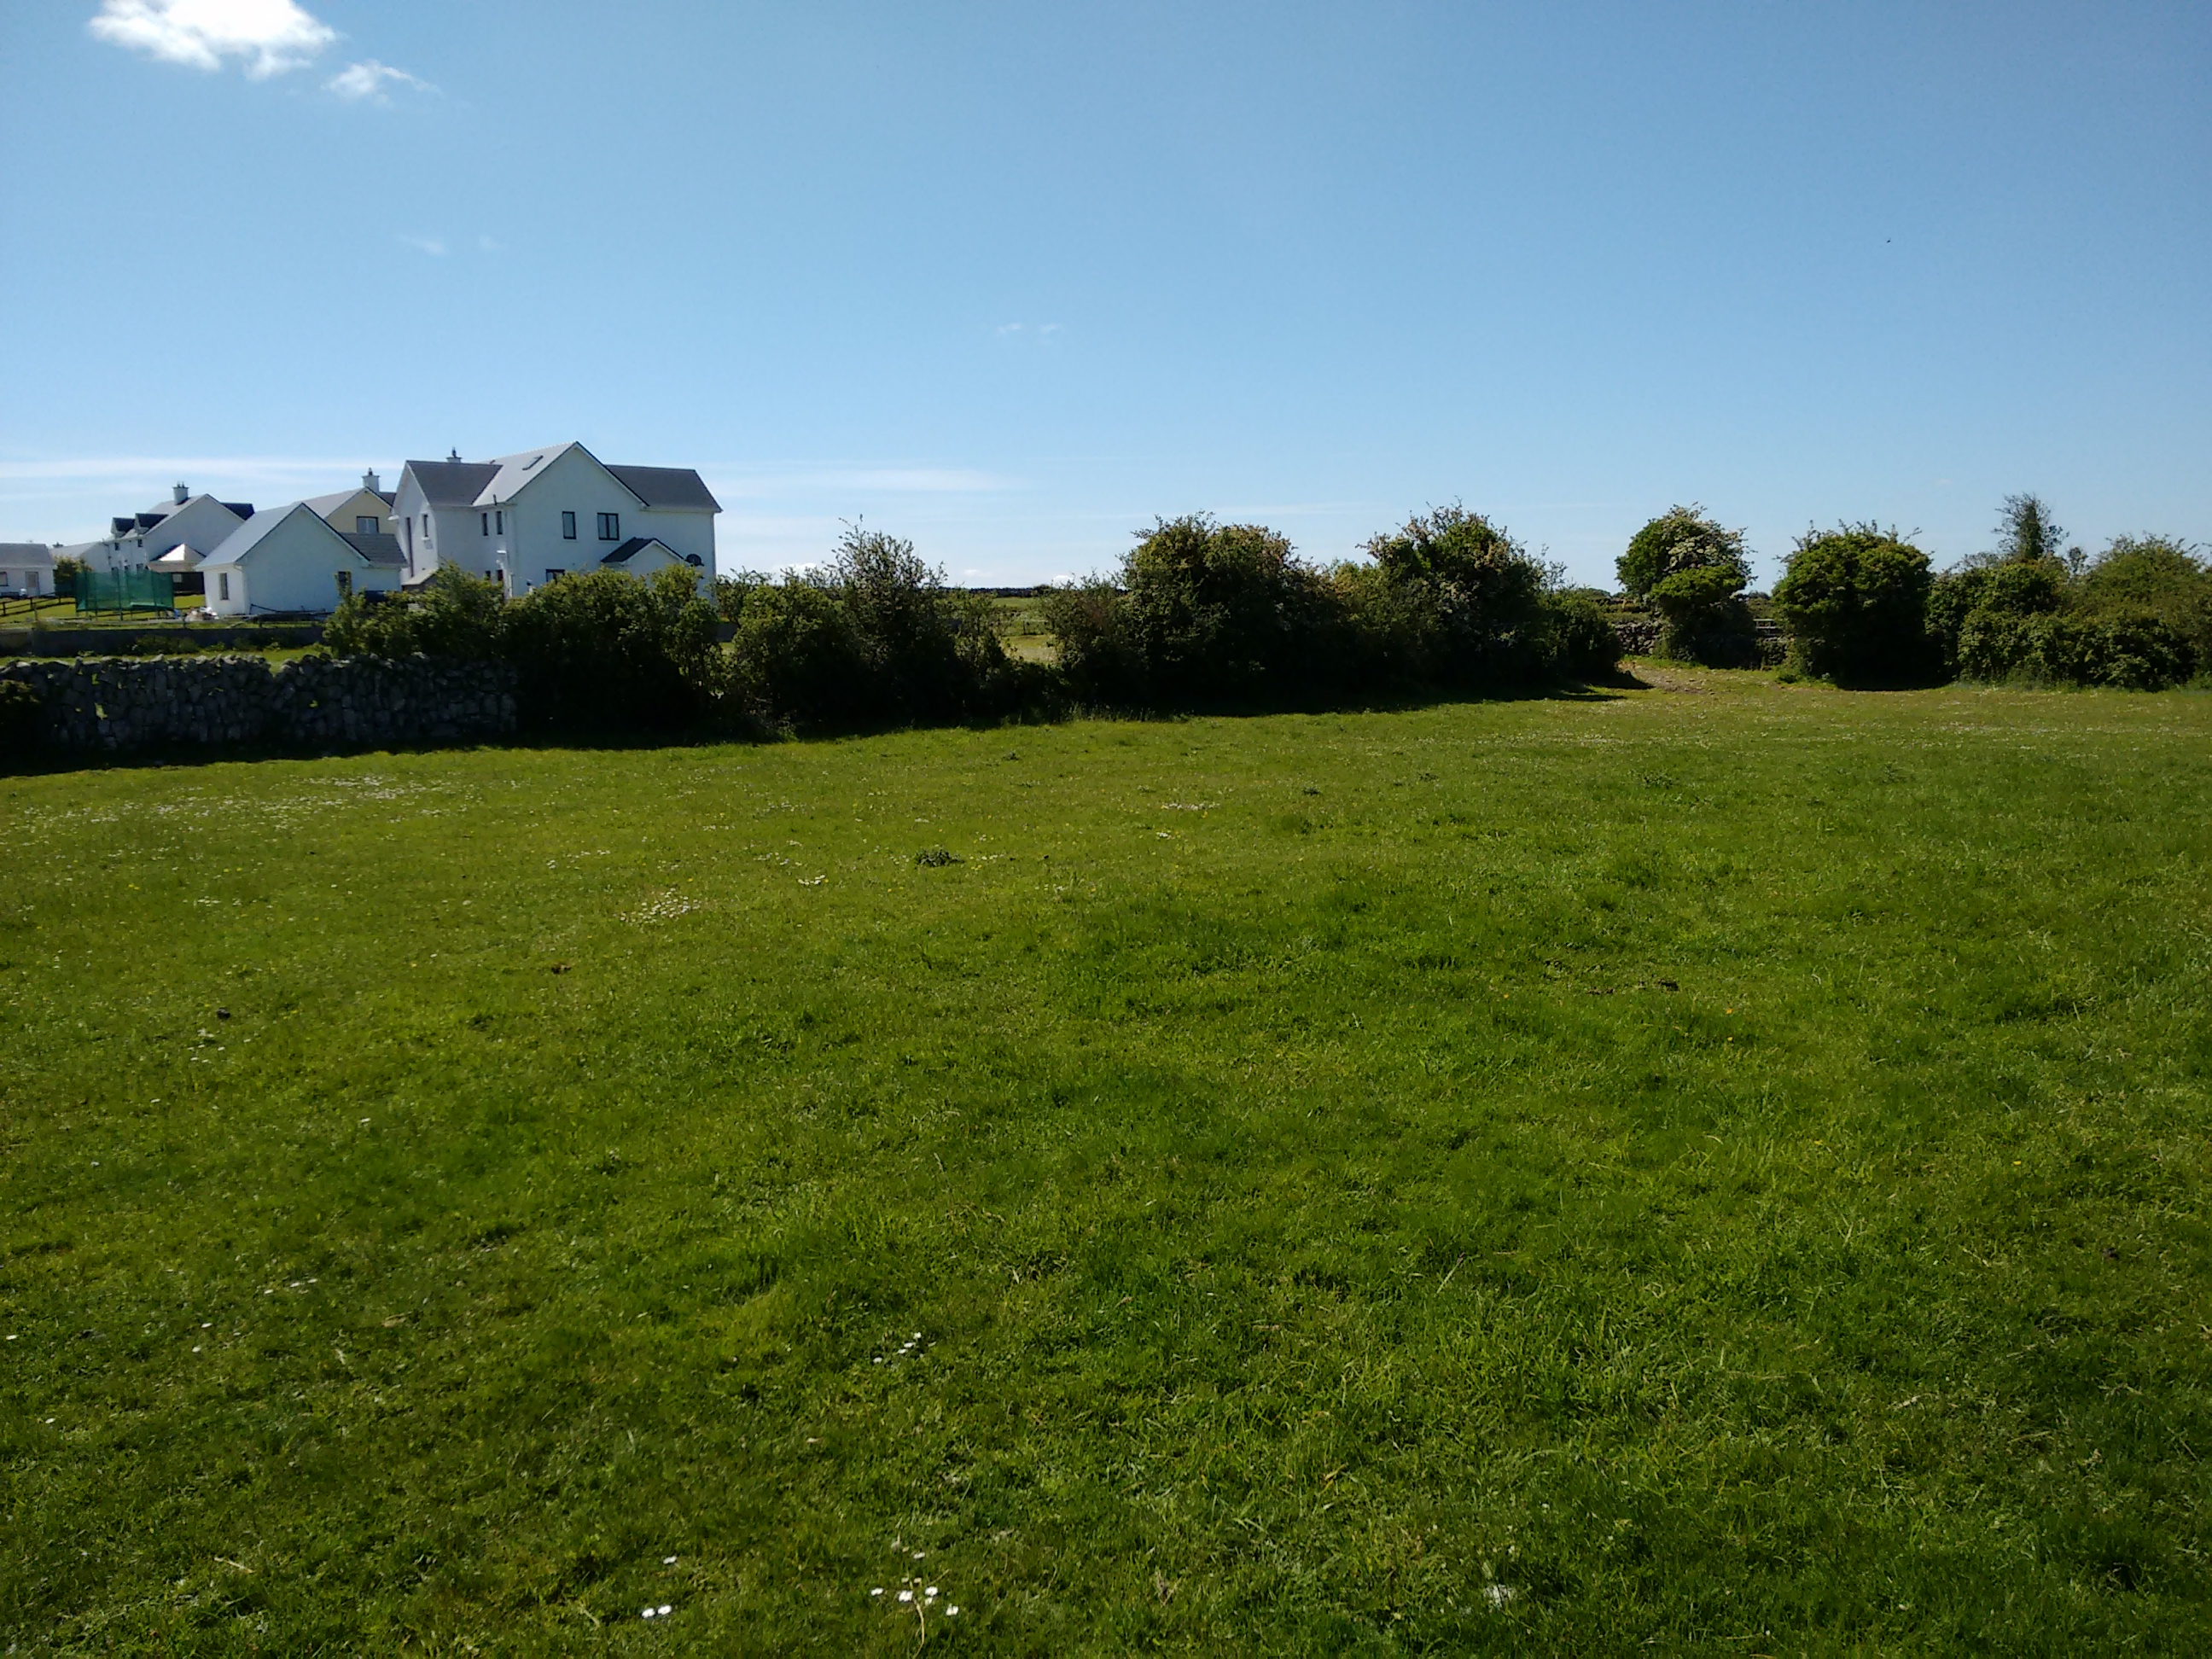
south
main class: Grassland
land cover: Grassland without tree/shrub cover
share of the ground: > 75 %
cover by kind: herbaceous plants 100 %
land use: Agriculture (excluding fallow land and kitchen gardens)
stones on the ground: < 10 %
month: June
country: IE
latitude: 53.1753
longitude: -8.8642
